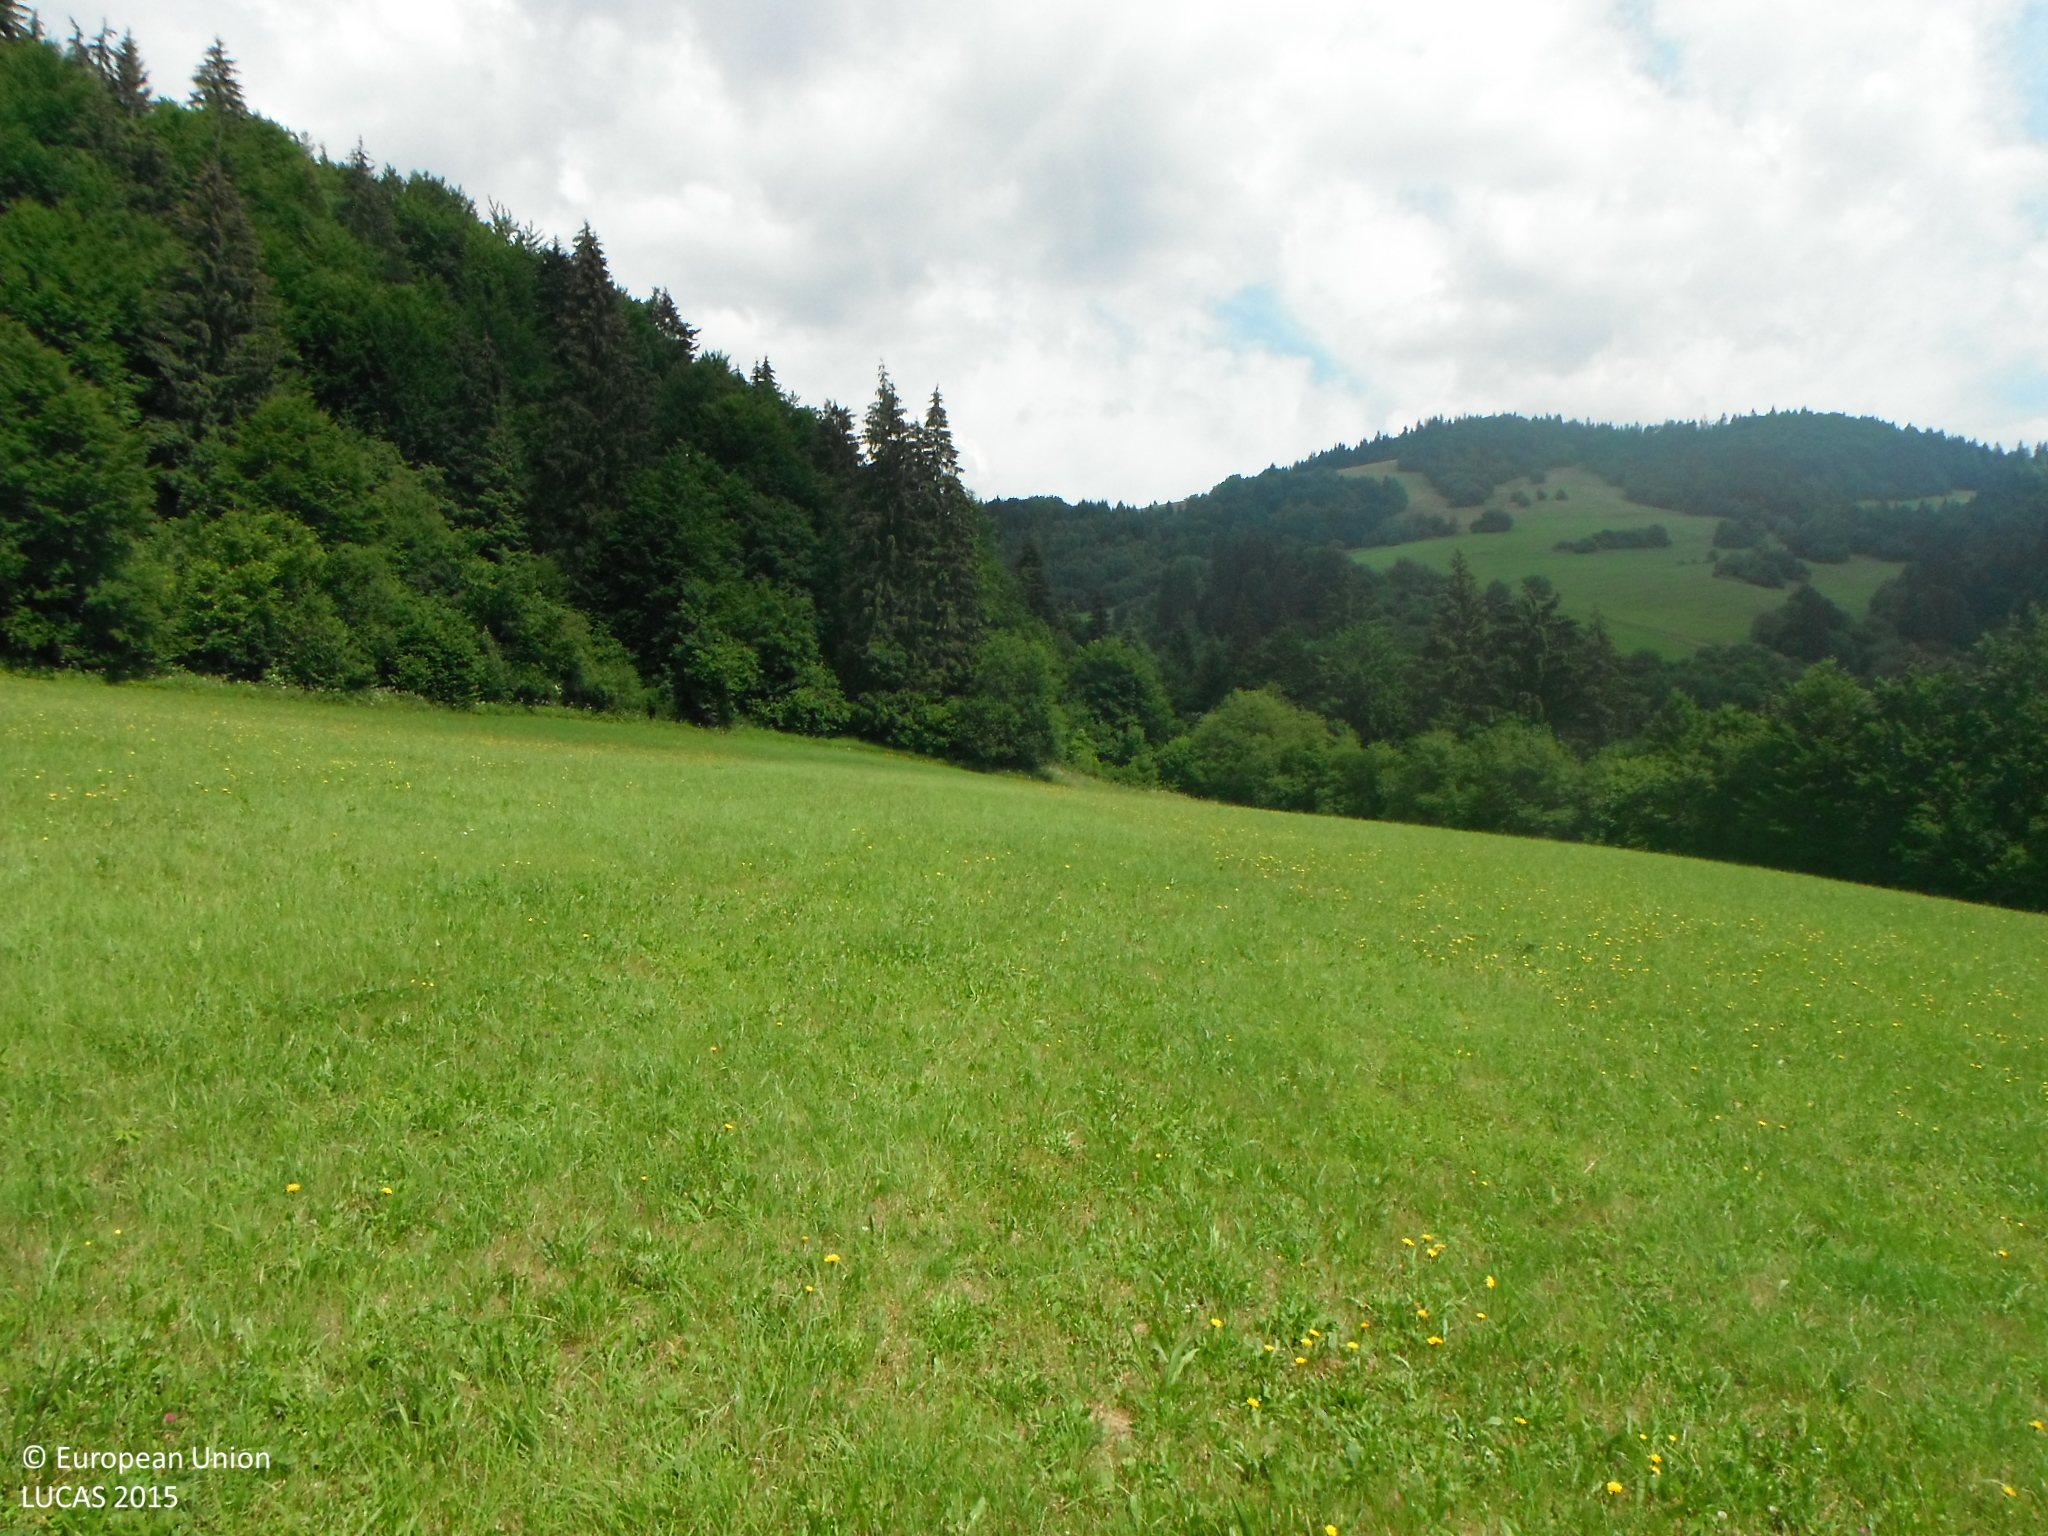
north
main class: Grassland
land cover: Grassland without tree/shrub cover
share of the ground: > 75 %
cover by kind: herbaceous plants 100 %
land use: Agriculture (excluding fallow land and kitchen gardens)
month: June
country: SK
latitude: 49.2845
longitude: 19.4429
